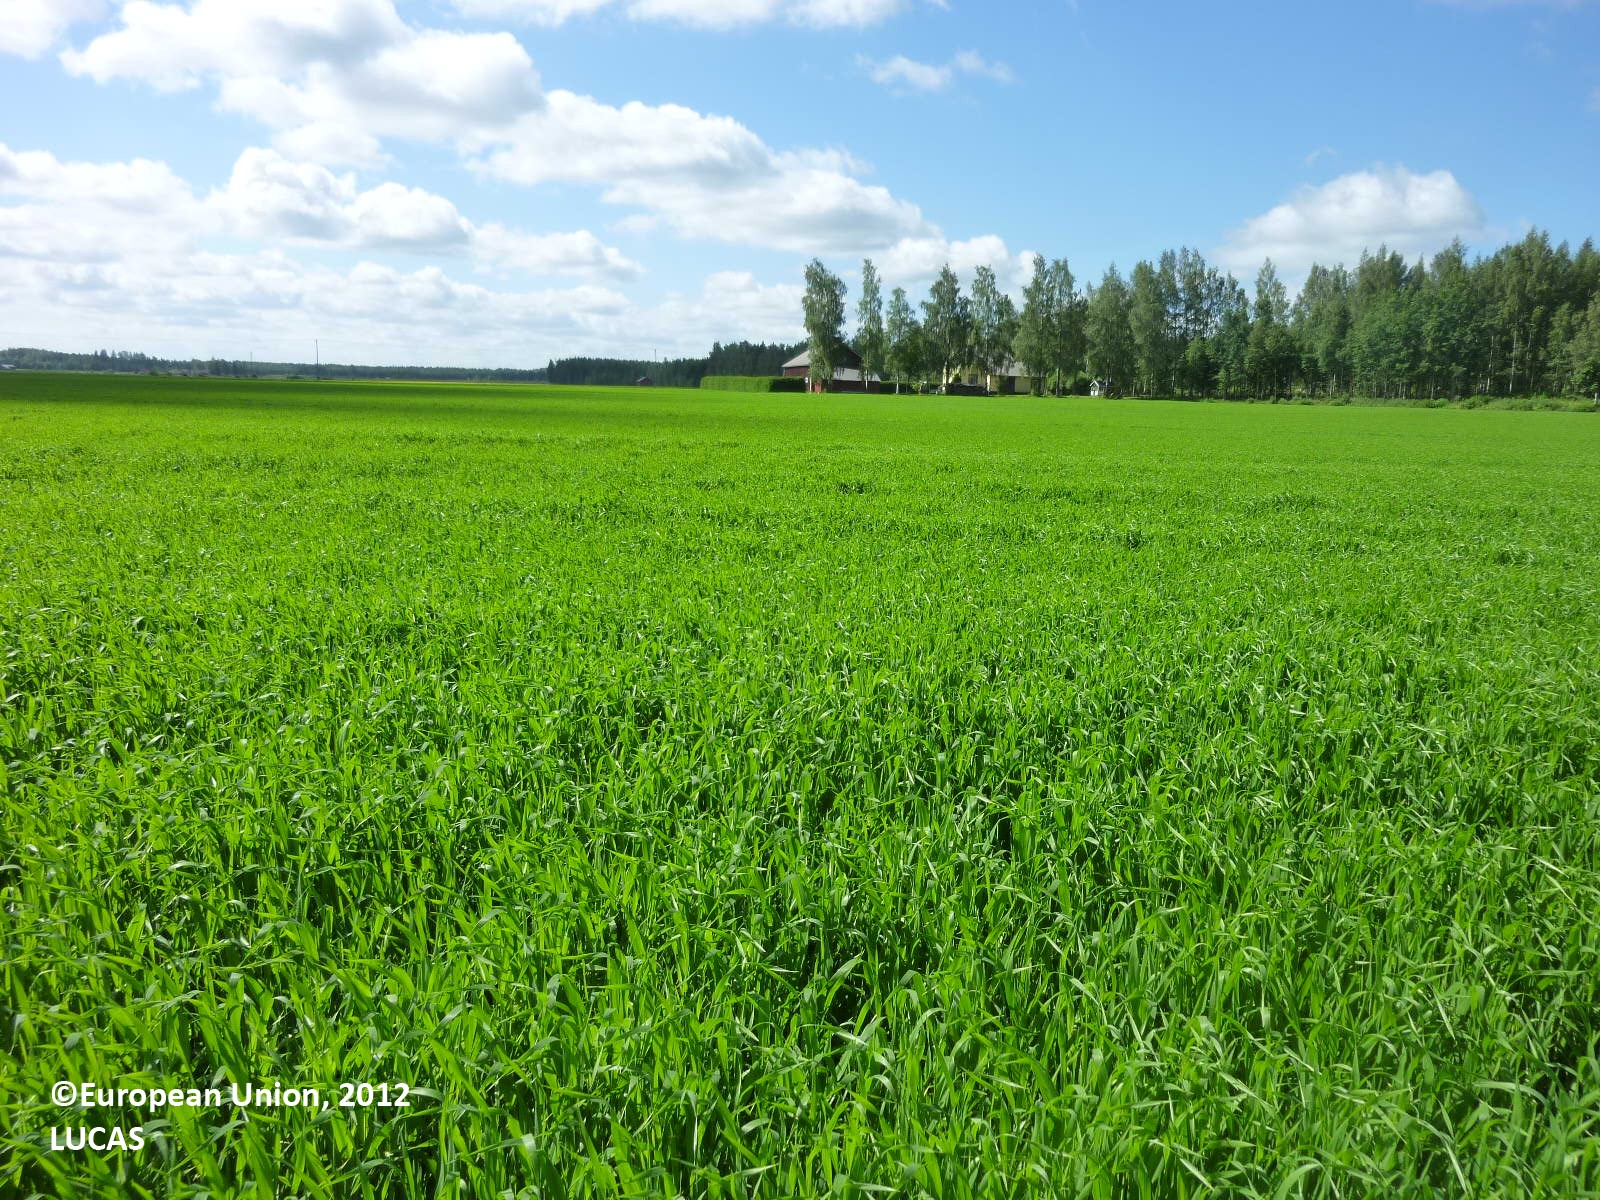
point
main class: Cropland
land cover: Barley
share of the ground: > 75 %
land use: Agriculture (excluding fallow land and kitchen gardens)
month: July
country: FI
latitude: 61.2910
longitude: 22.2096
